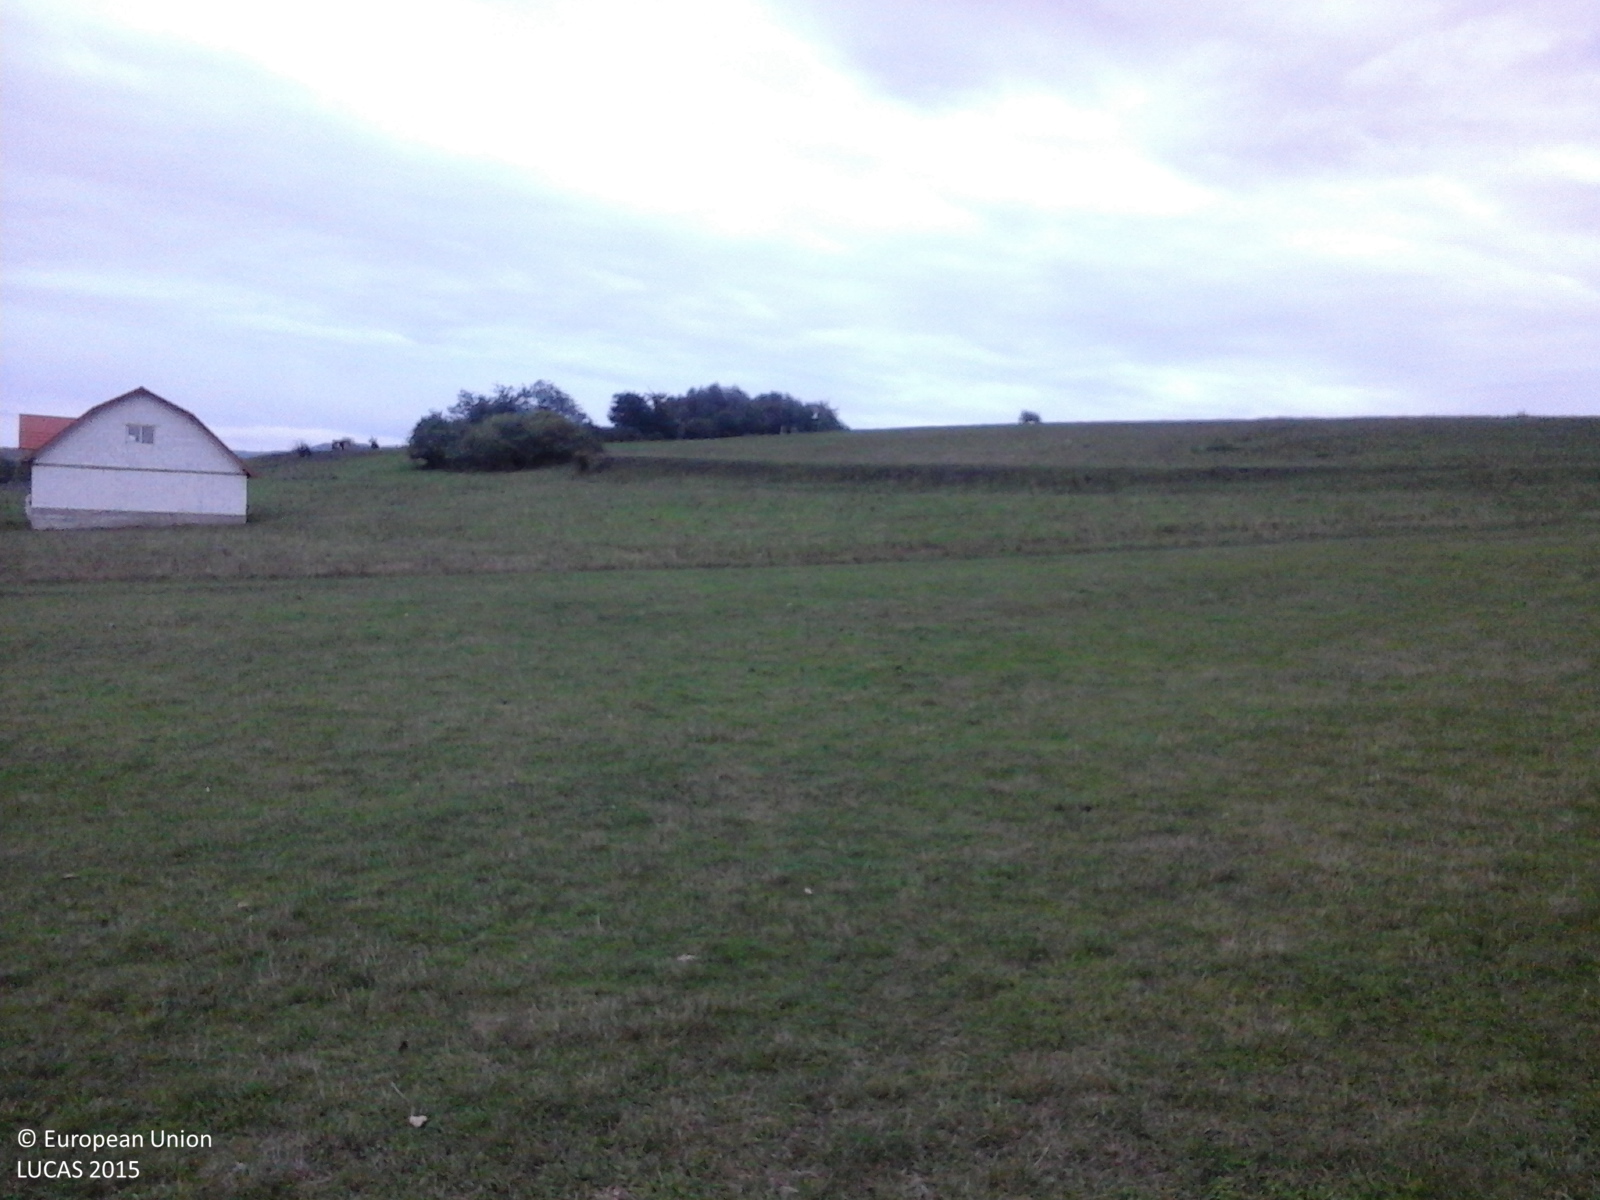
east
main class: Grassland
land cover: Grassland without tree/shrub cover
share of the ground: > 75 %
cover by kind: herbaceous plants 100 %
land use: Agriculture (excluding fallow land and kitchen gardens)
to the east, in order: Grassland without tree/shrub cover; Tracks; Grassland without tree/shrub cover
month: September
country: RO
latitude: 45.9832
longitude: 23.5022
